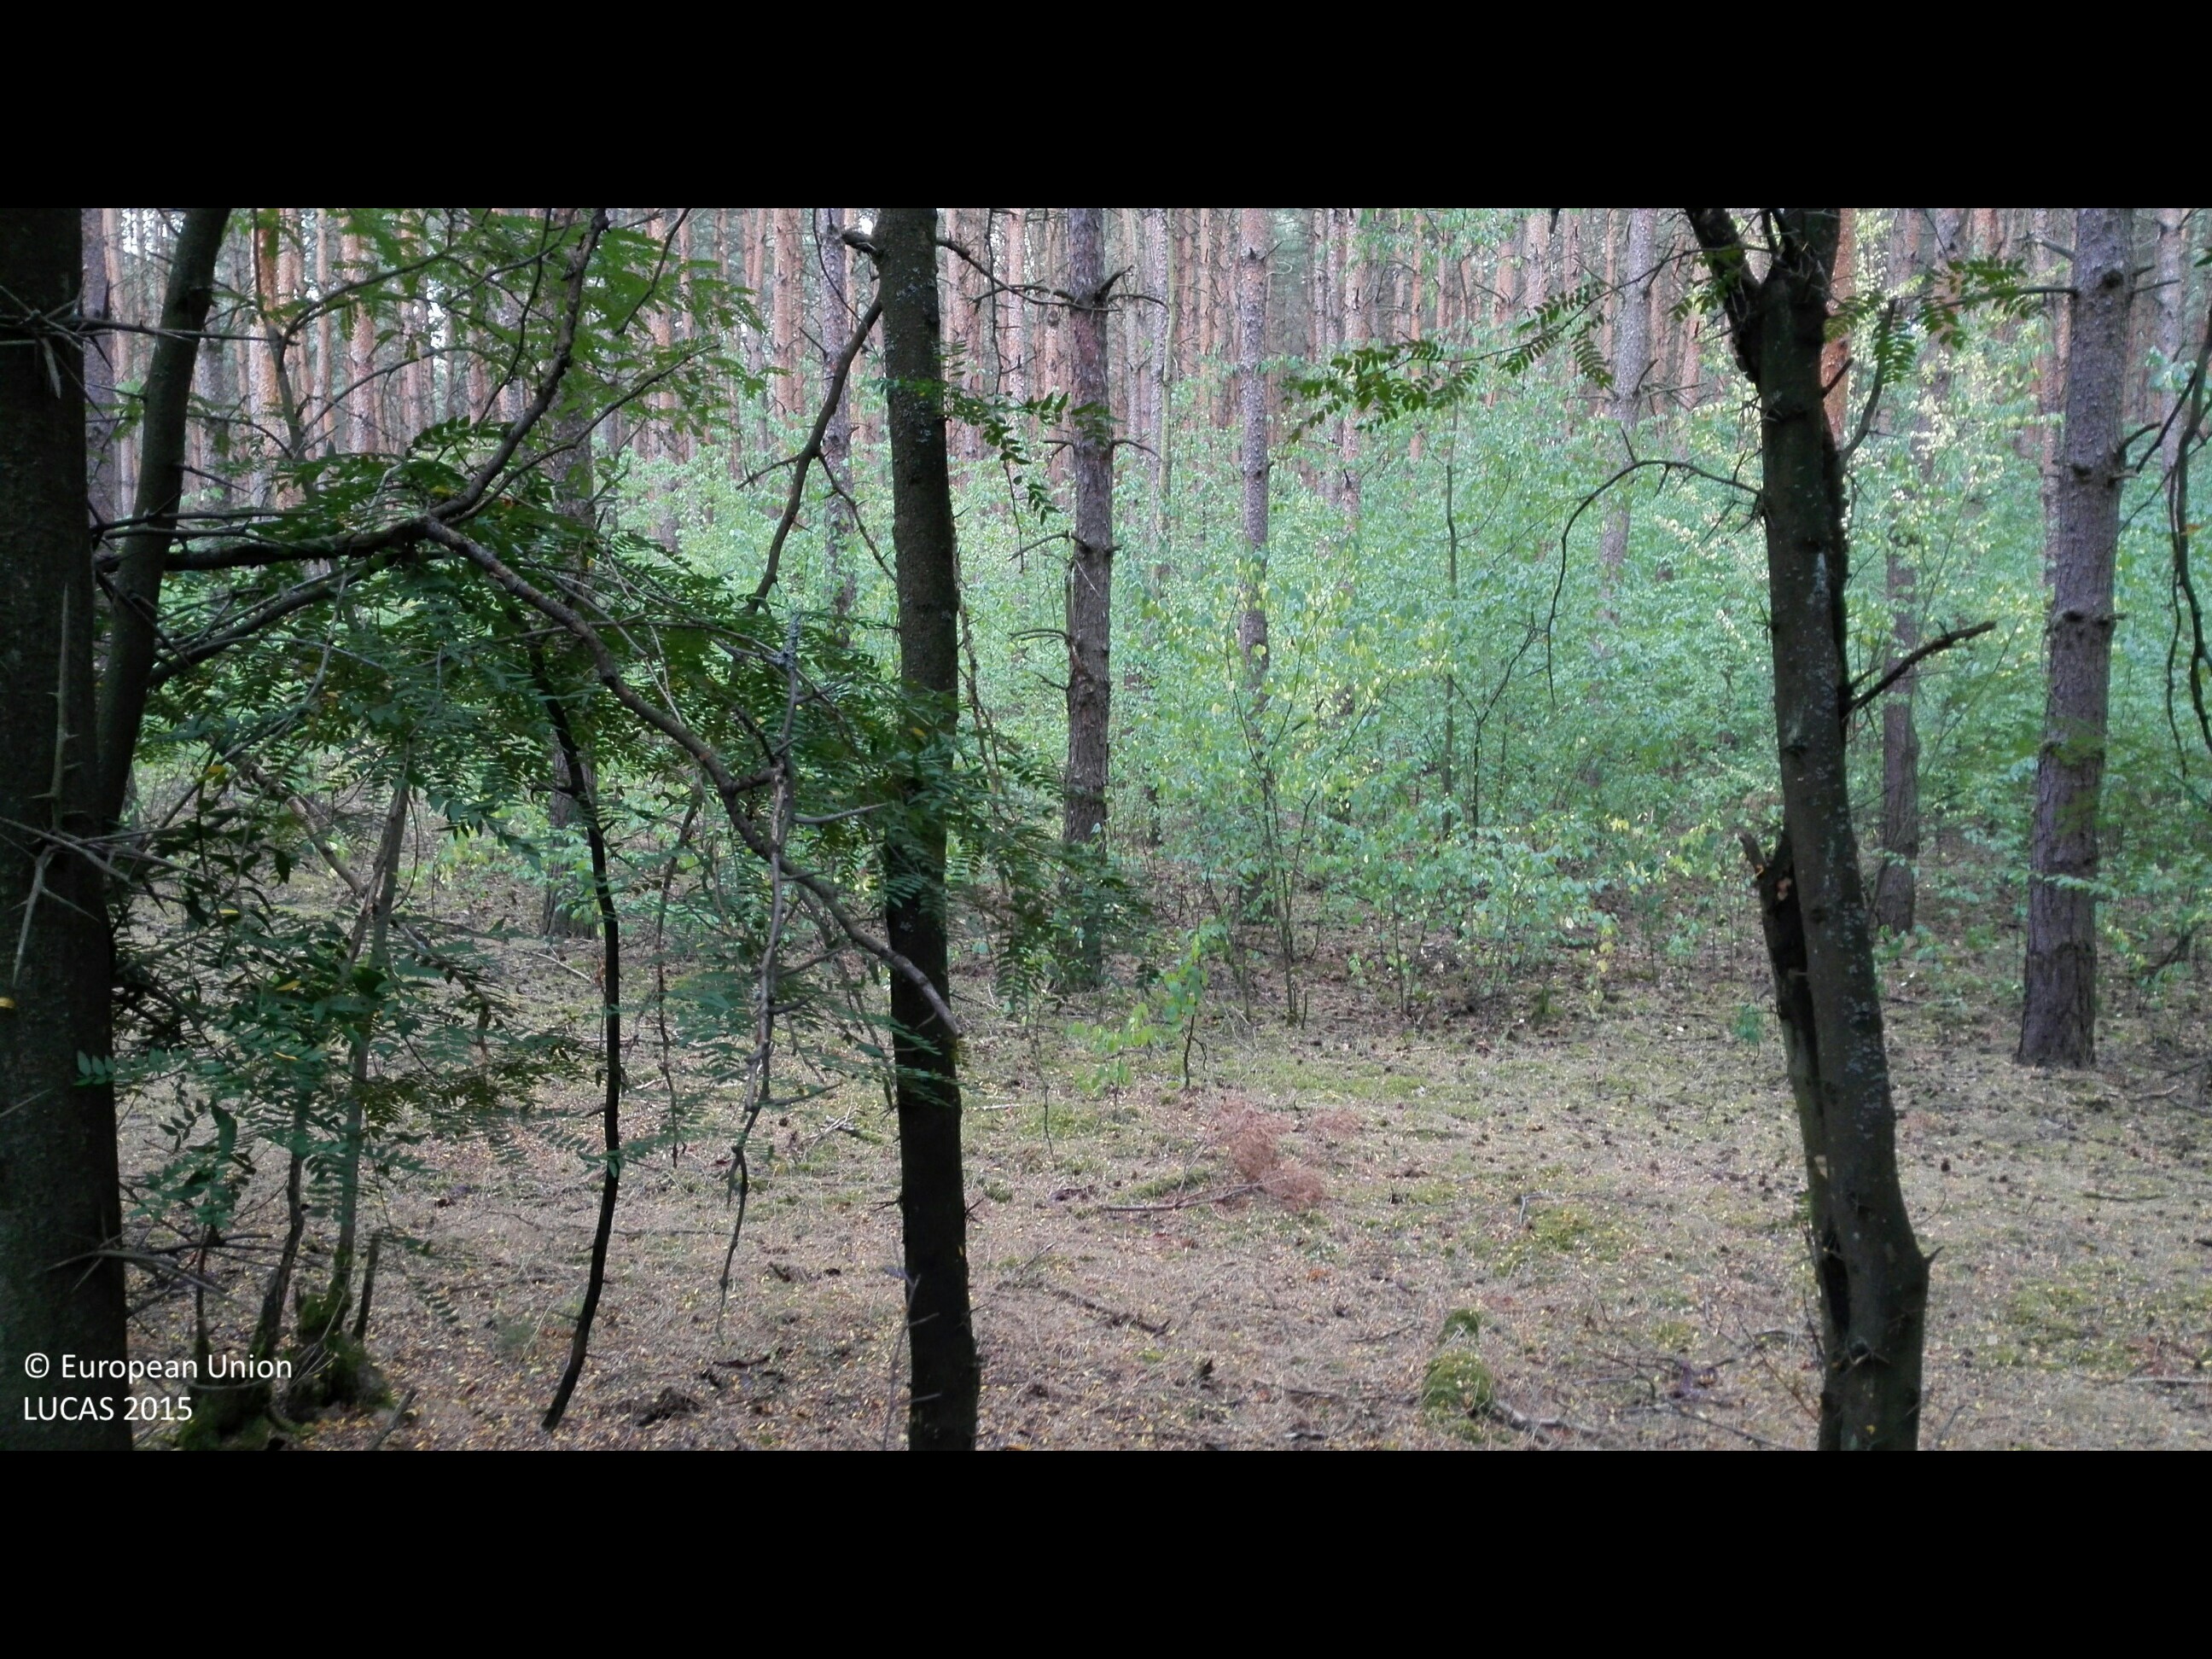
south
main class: Woodland
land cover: Broadleaved woodland
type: exotic forest
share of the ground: > 75 %
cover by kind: broadleaved forest trees 100 %
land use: Forestry
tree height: > 5 m
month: August
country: HU
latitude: 47.4054
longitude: 21.8004
